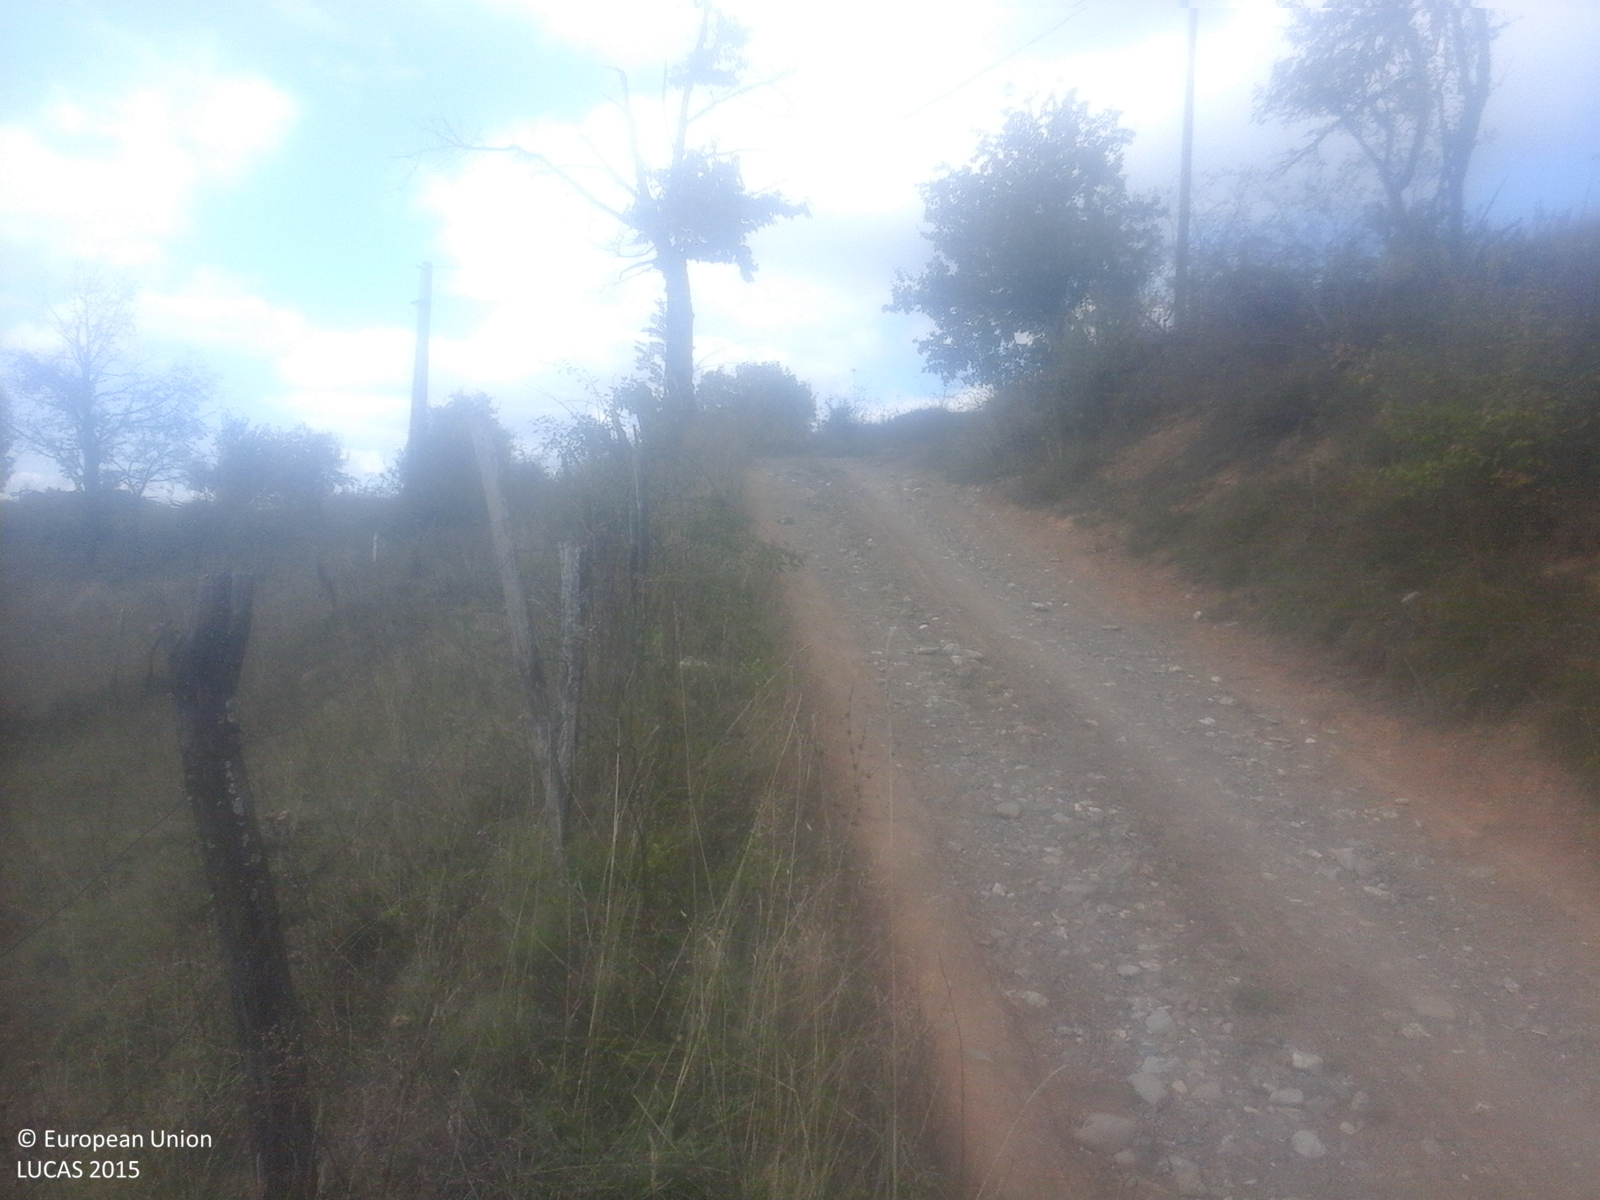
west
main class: Grassland
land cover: Grassland without tree/shrub cover
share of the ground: > 75 %
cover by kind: herbaceous plants 100 %
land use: Agriculture (excluding fallow land and kitchen gardens)
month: October
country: RO
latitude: 46.2366
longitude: 22.9336
